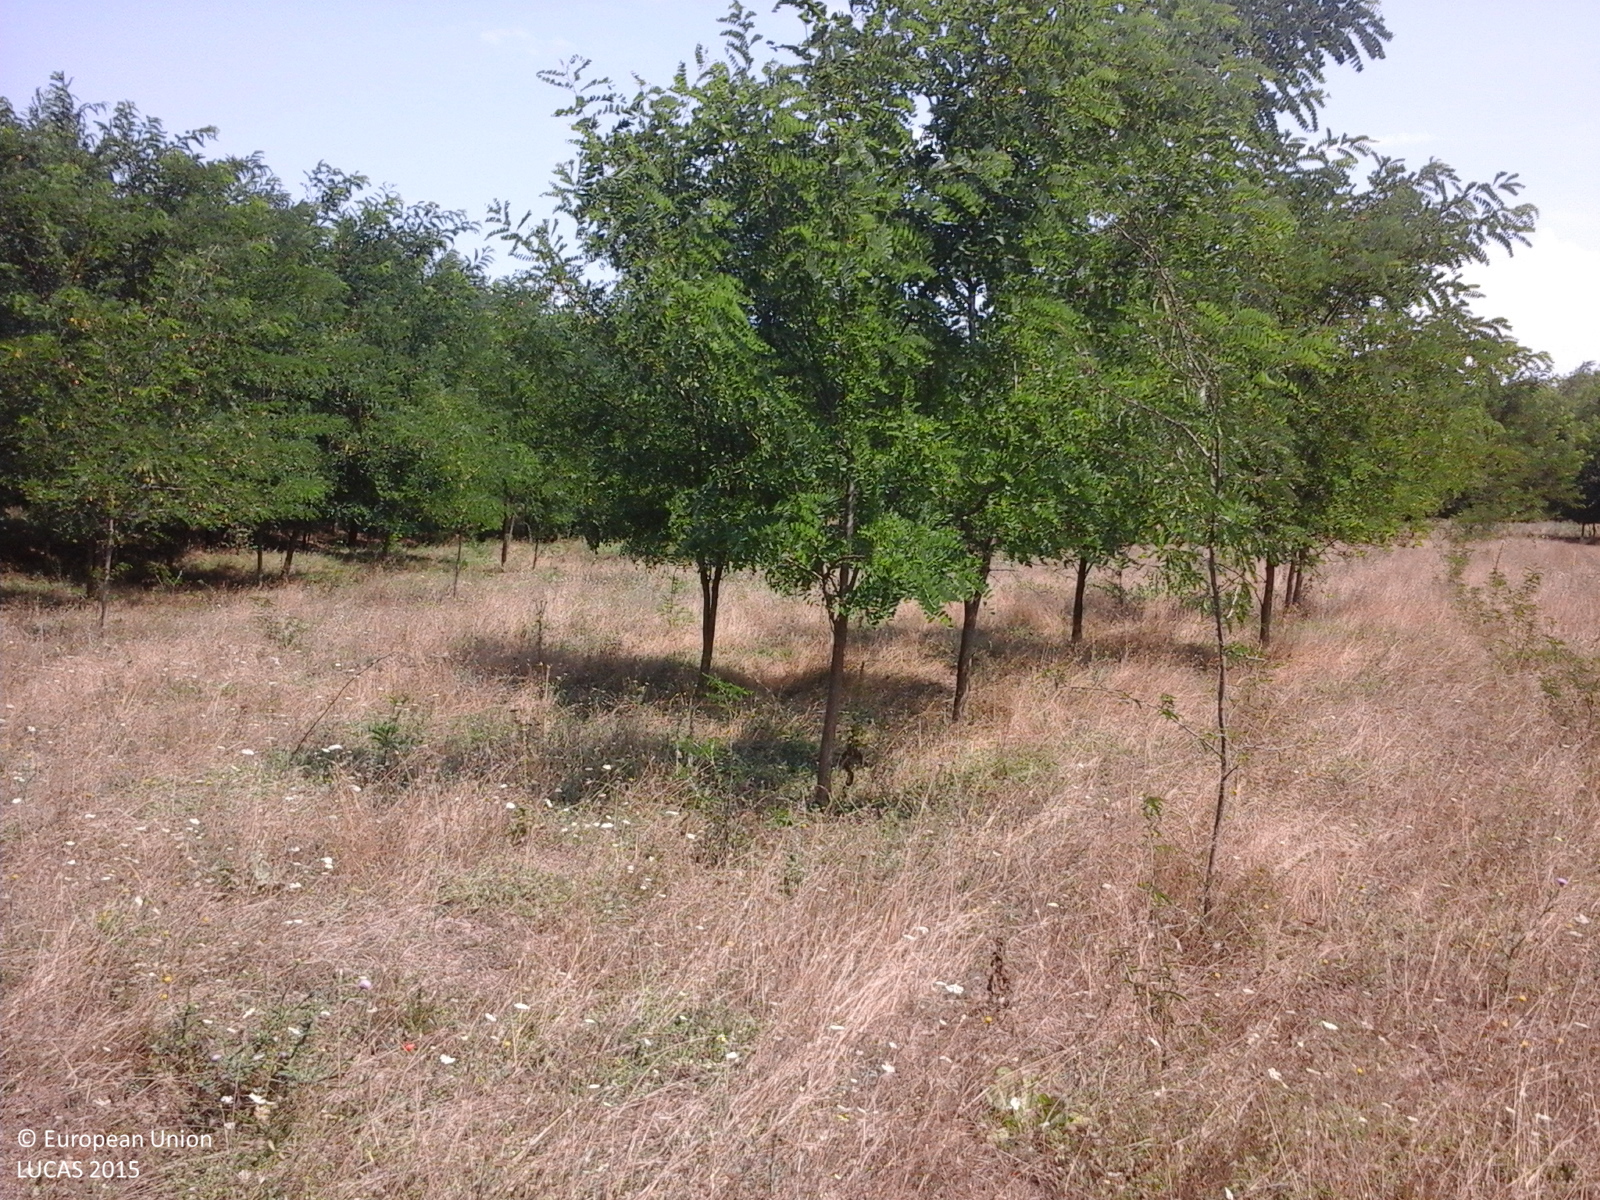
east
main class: Woodland
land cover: Broadleaved woodland
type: exotic forest
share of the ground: > 75 %
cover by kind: broadleaved forest trees 100 %
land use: Forestry
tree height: > 5 m
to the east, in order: Broadleaved woodland; Grassland with sparse tree/shrub cover; Broadleaved woodland
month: August
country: RO
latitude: 44.1583
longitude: 28.0230
